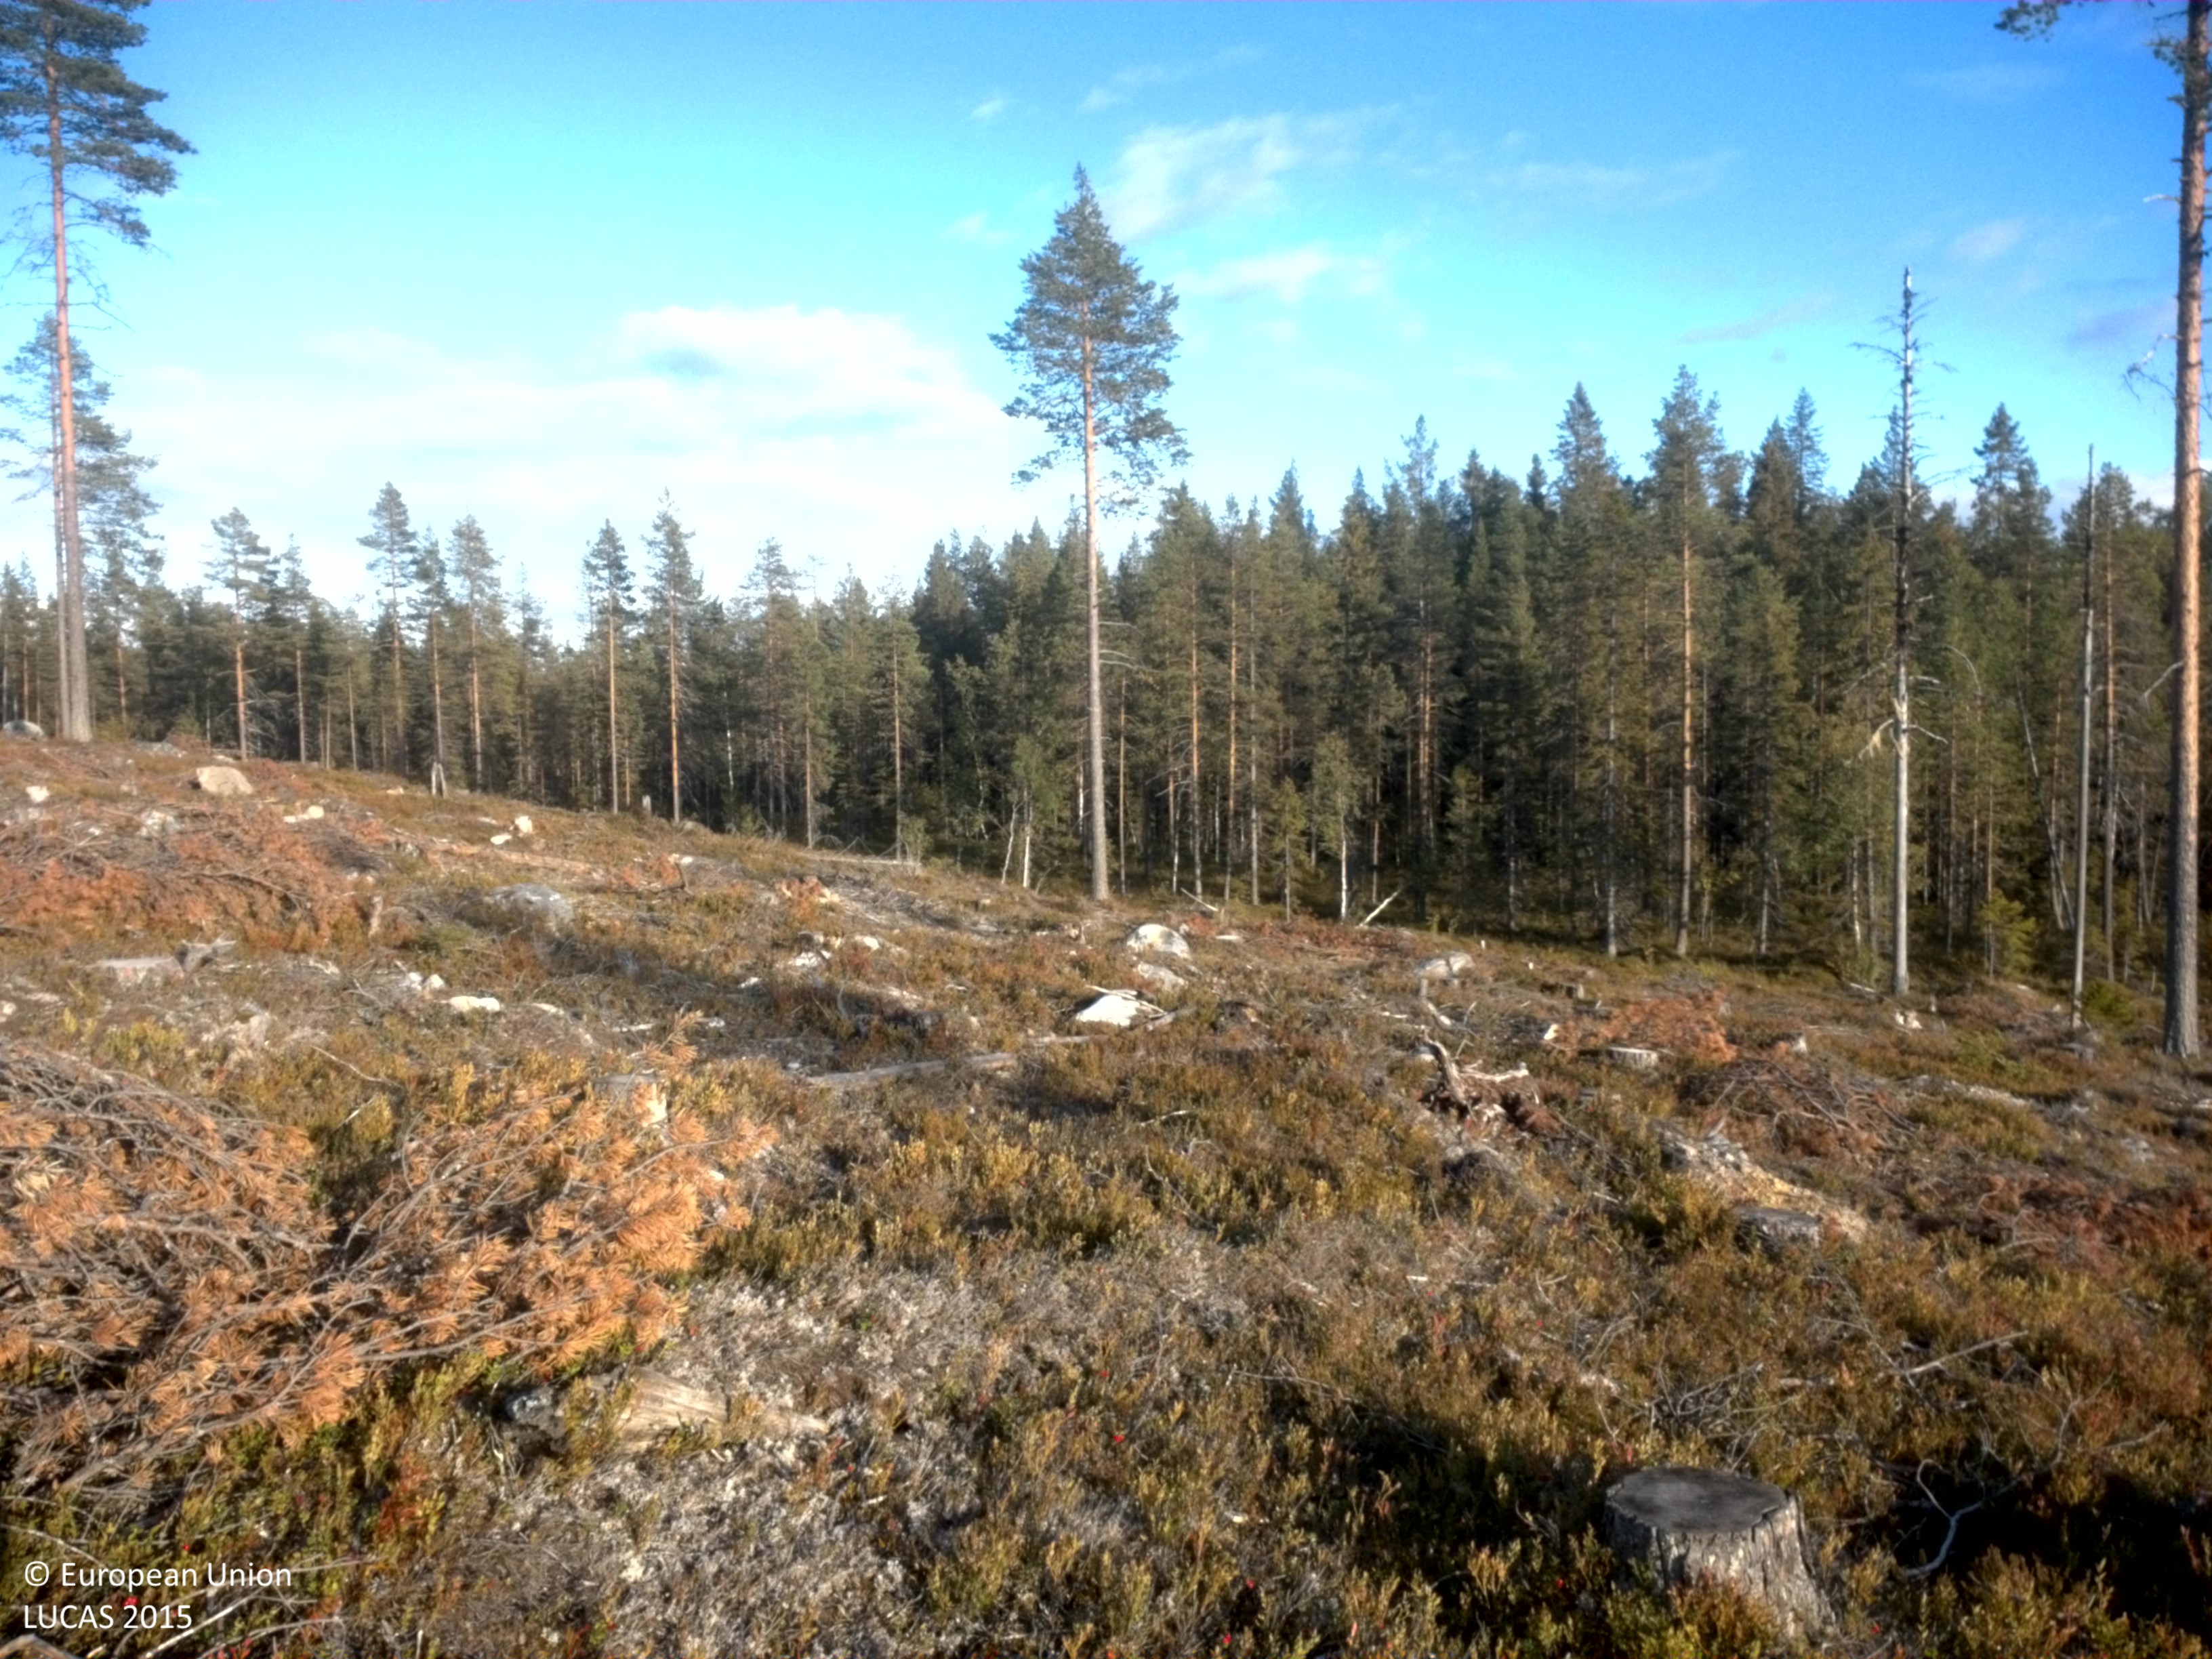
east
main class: Woodland
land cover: Pine dominated coniferous woodland
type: boreal forest
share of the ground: 10 - 25 %
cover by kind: shrubs 75 %, lichens and mosses 15 %, coniferous forest trees 10 %
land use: Forestry
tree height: > 5 m
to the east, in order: Pine dominated coniferous woodland; Spruce dominated mixed woodland; Pine dominated coniferous woodland; Ditches and canals; Pine dominated coniferous woodland; Other mixed woodland; Pine dominated coniferous woodland
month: September
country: SE
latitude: 64.4458
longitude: 19.7177
